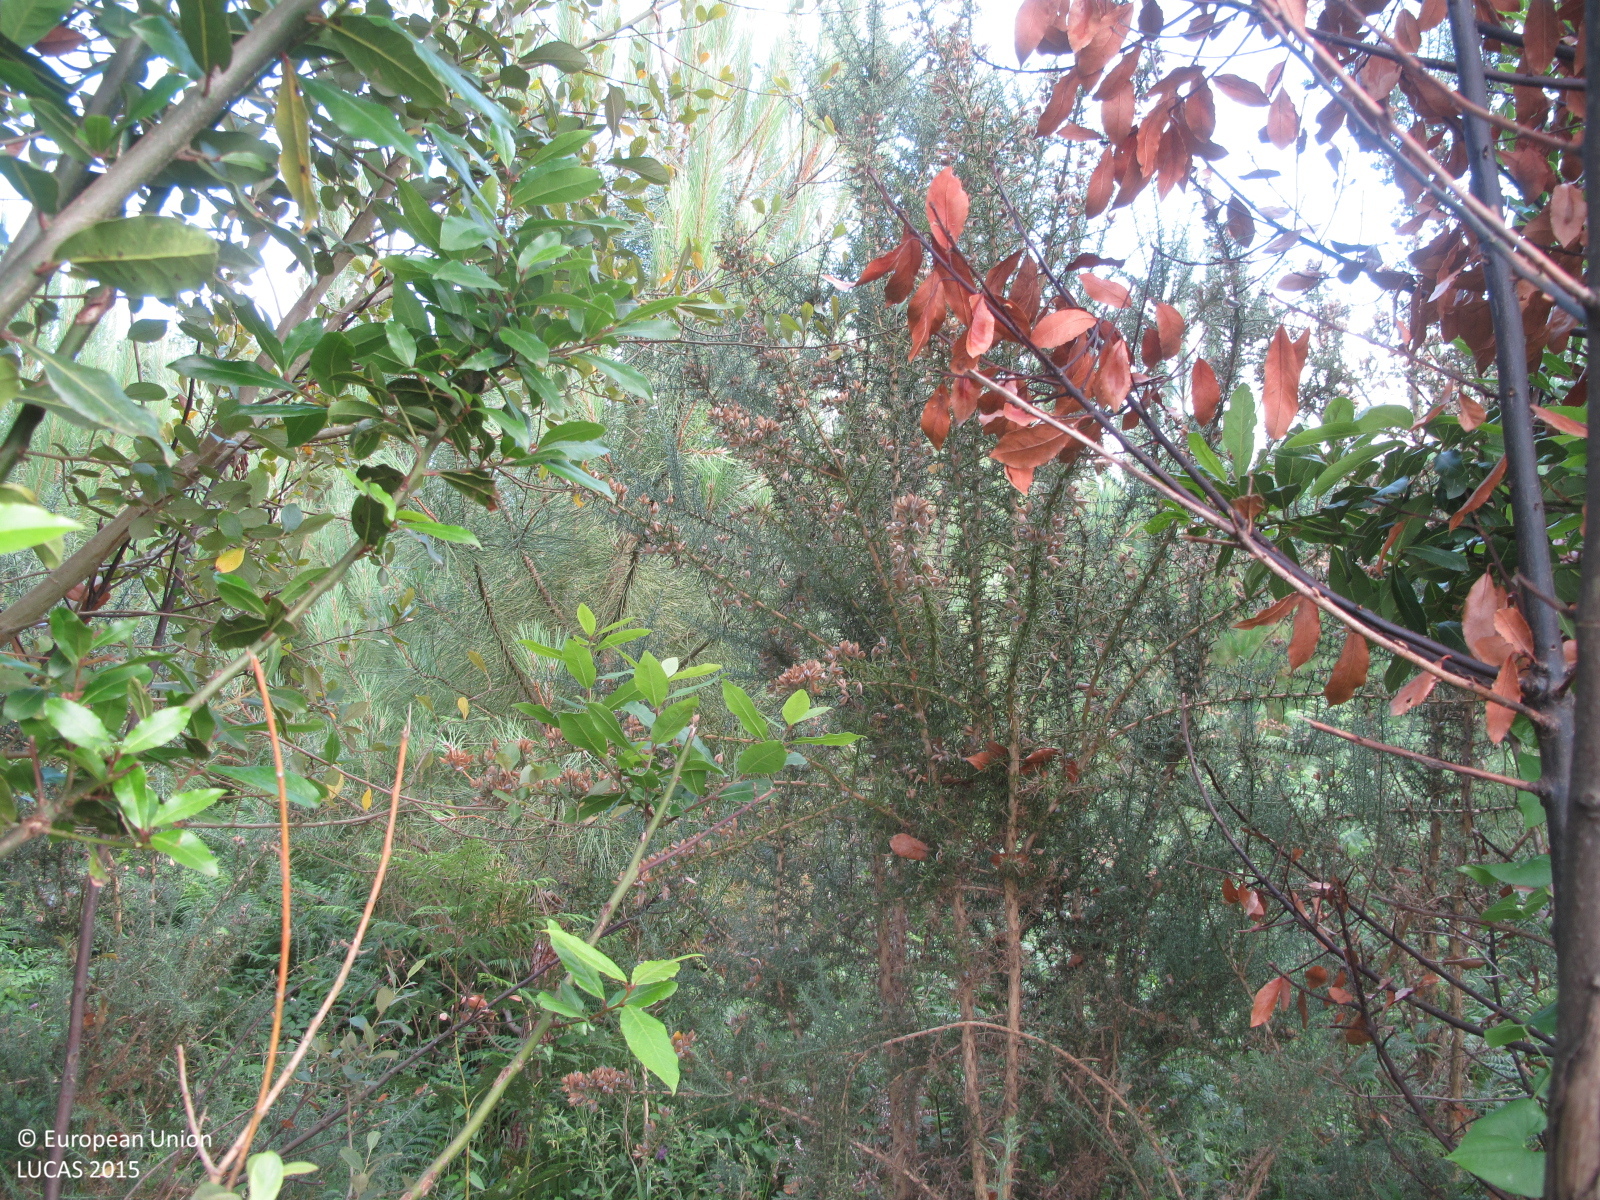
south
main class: Woodland
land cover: Pine dominated mixed woodland
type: exotic forest
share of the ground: 50 - 75 %
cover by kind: coniferous forest trees 40 %, shrubs 40 %, broadleaved forest trees 20 %
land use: Forestry
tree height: > 5 m
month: July
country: ES
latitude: 43.5697
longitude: -8.0137
